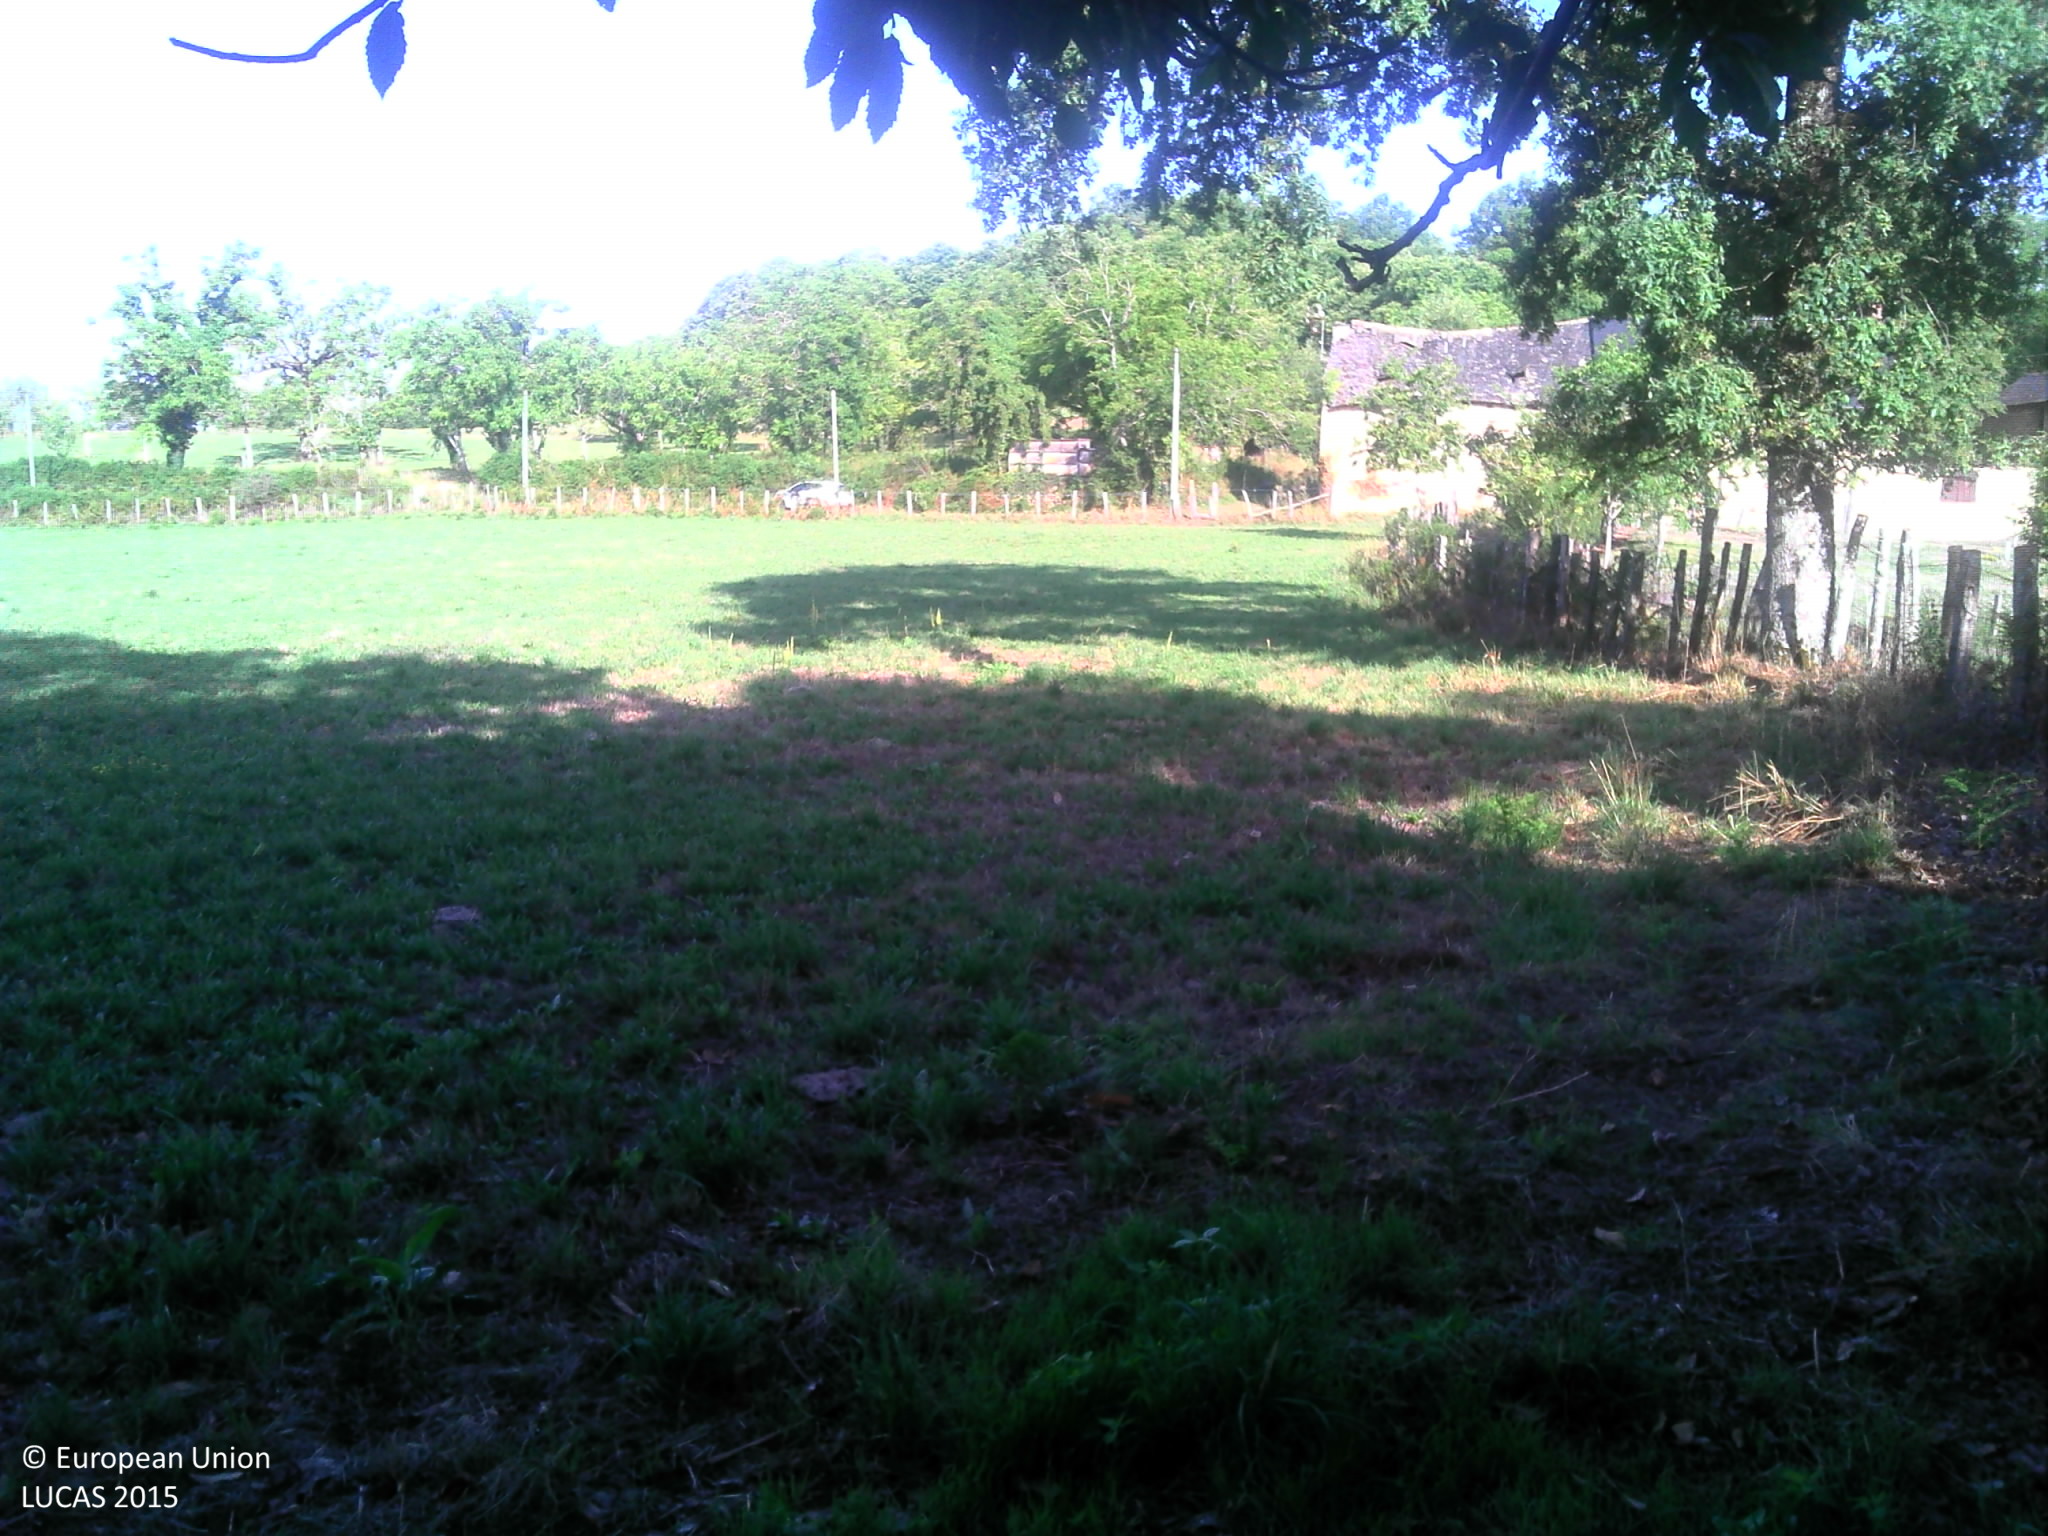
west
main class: Woodland
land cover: Broadleaved woodland
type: thermophilous deciduous forest
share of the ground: 25 - 50 %
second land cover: Grassland without tree/shrub cover
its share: > 75 %
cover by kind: herbaceous plants 60 %, broadleaved forest trees 40 %
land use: Forestry
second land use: Agriculture (excluding fallow land and kitchen gardens)
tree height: > 5 m
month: August
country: FR
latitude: 45.2892
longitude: 1.5158
